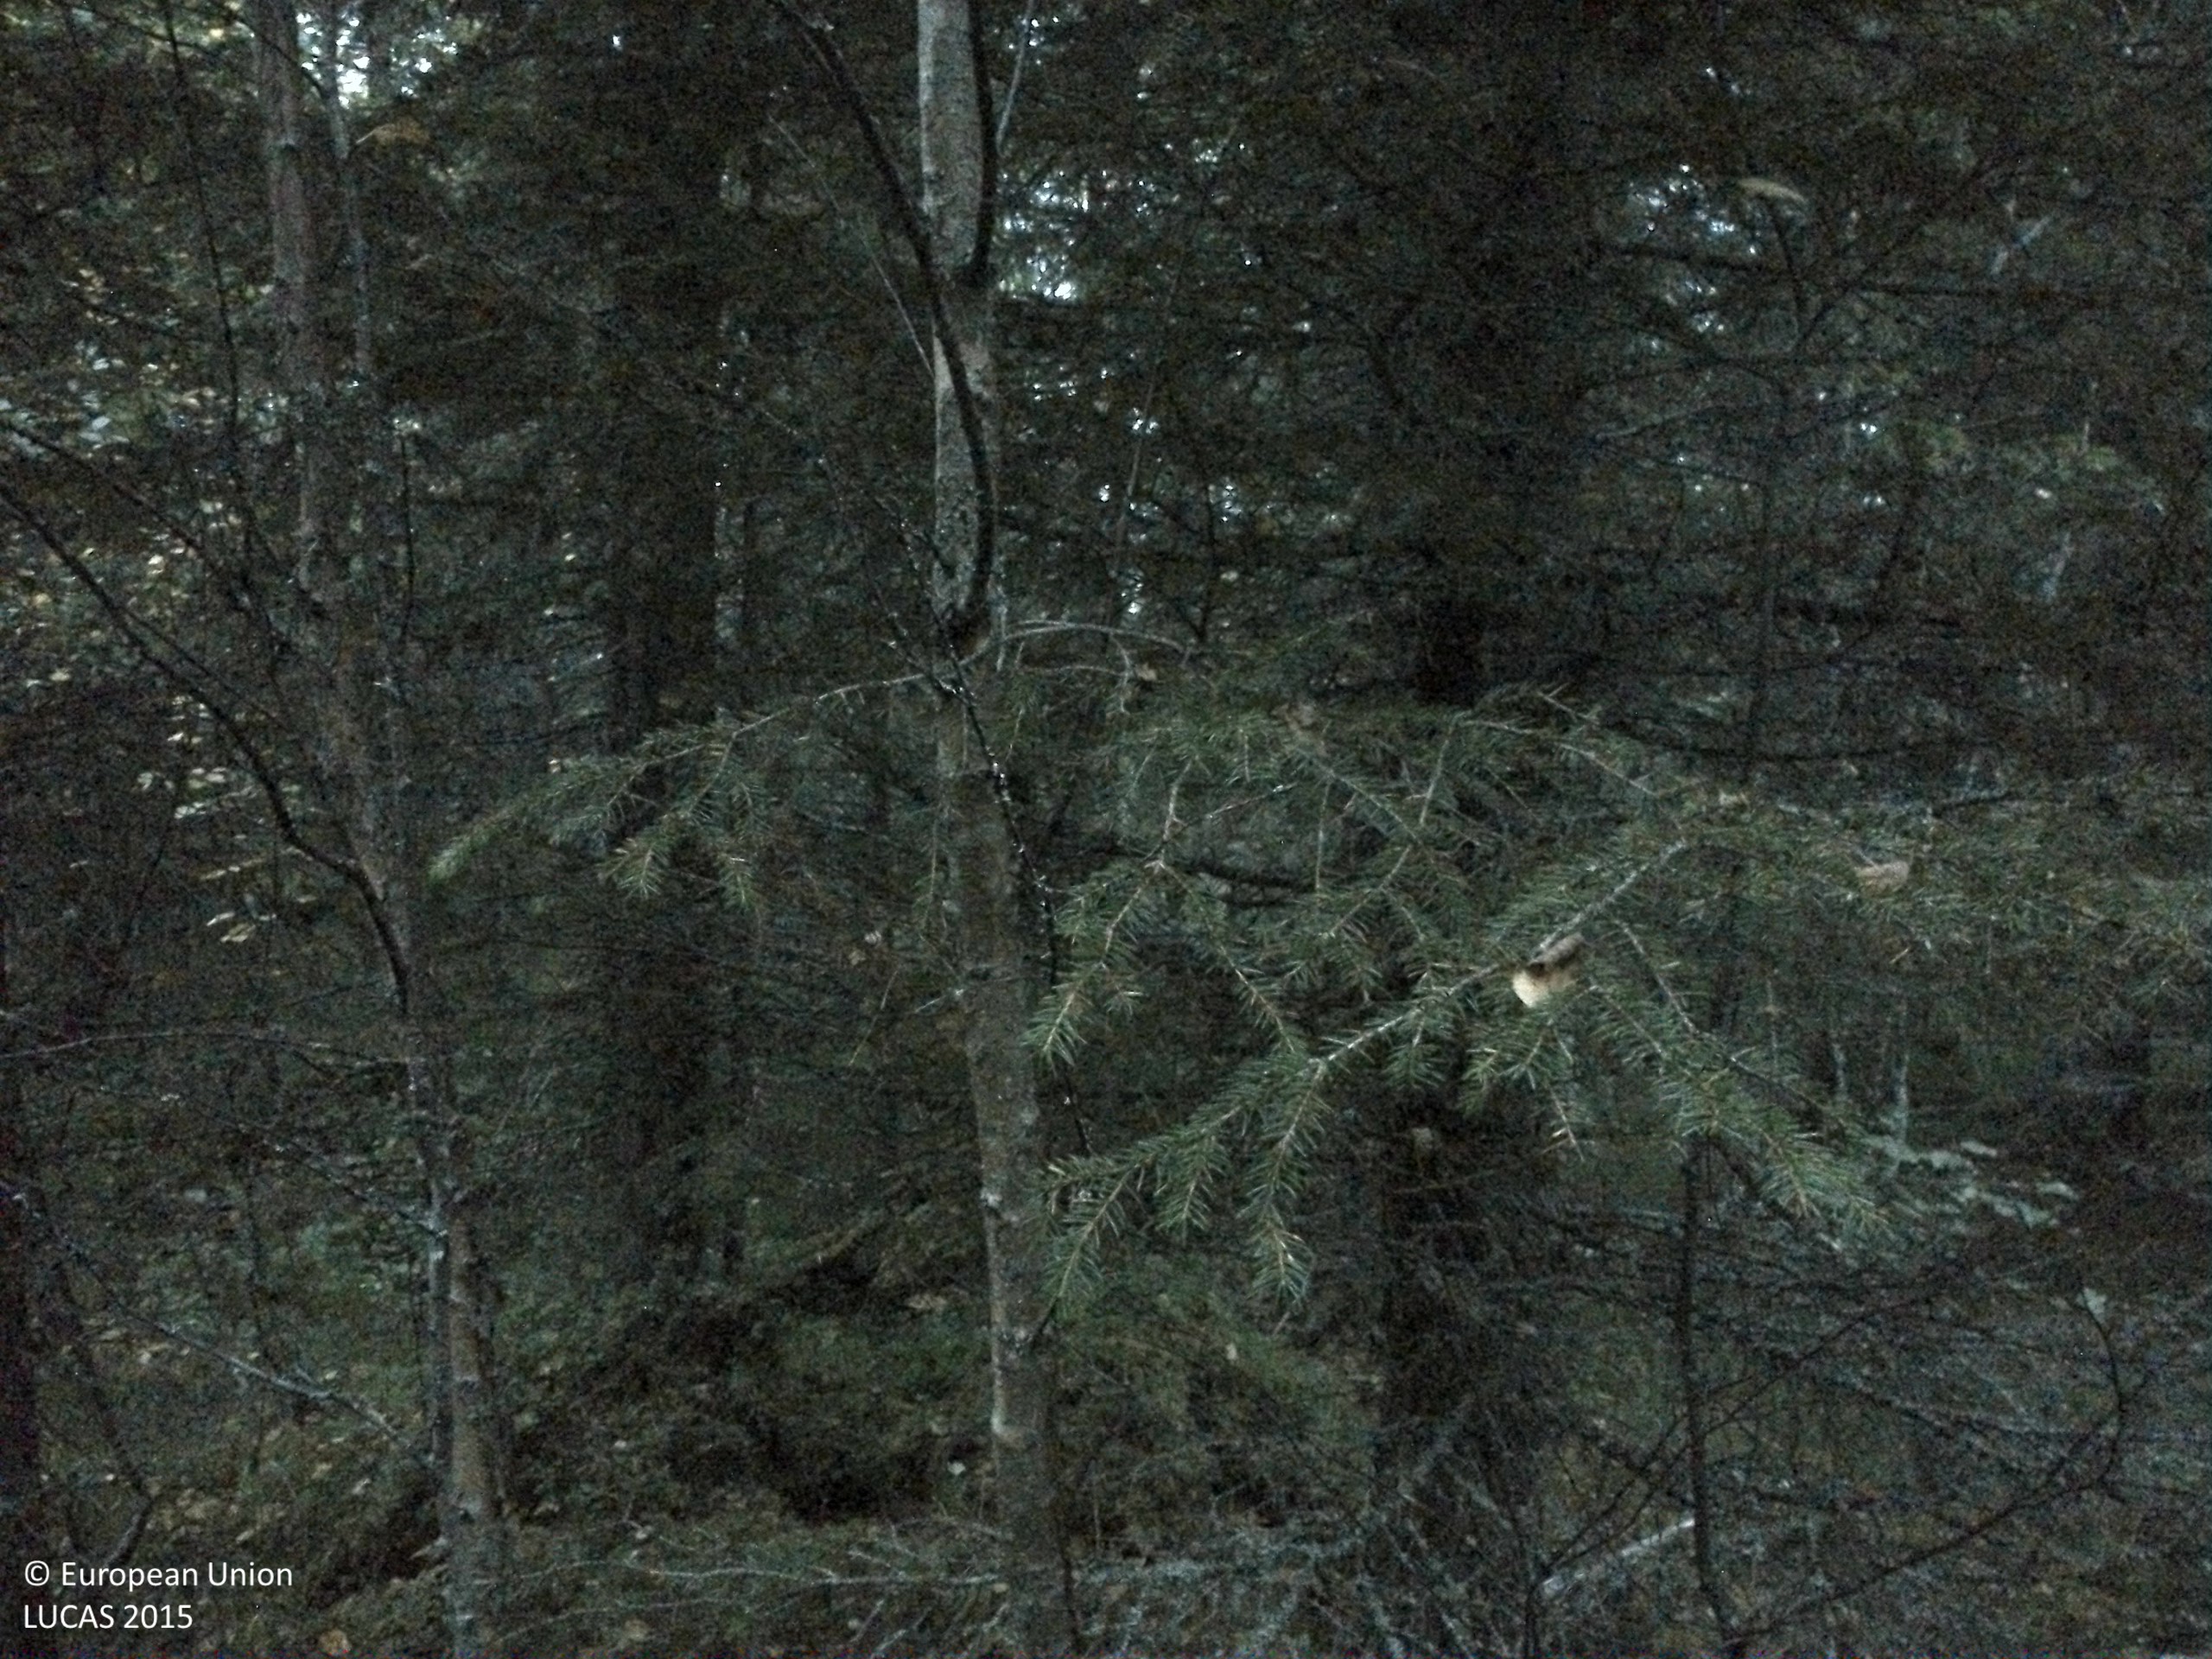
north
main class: Woodland
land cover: Spruce dominated mixed woodland
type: boreal forest
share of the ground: > 75 %
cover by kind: coniferous forest trees 50 %, broadleaved forest trees 25 %, shrubs 10 %, herbaceous plants 10 %, lichens and mosses 5 %
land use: Forestry
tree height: > 5 m
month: September
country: SE
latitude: 63.6161
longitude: 15.9641
